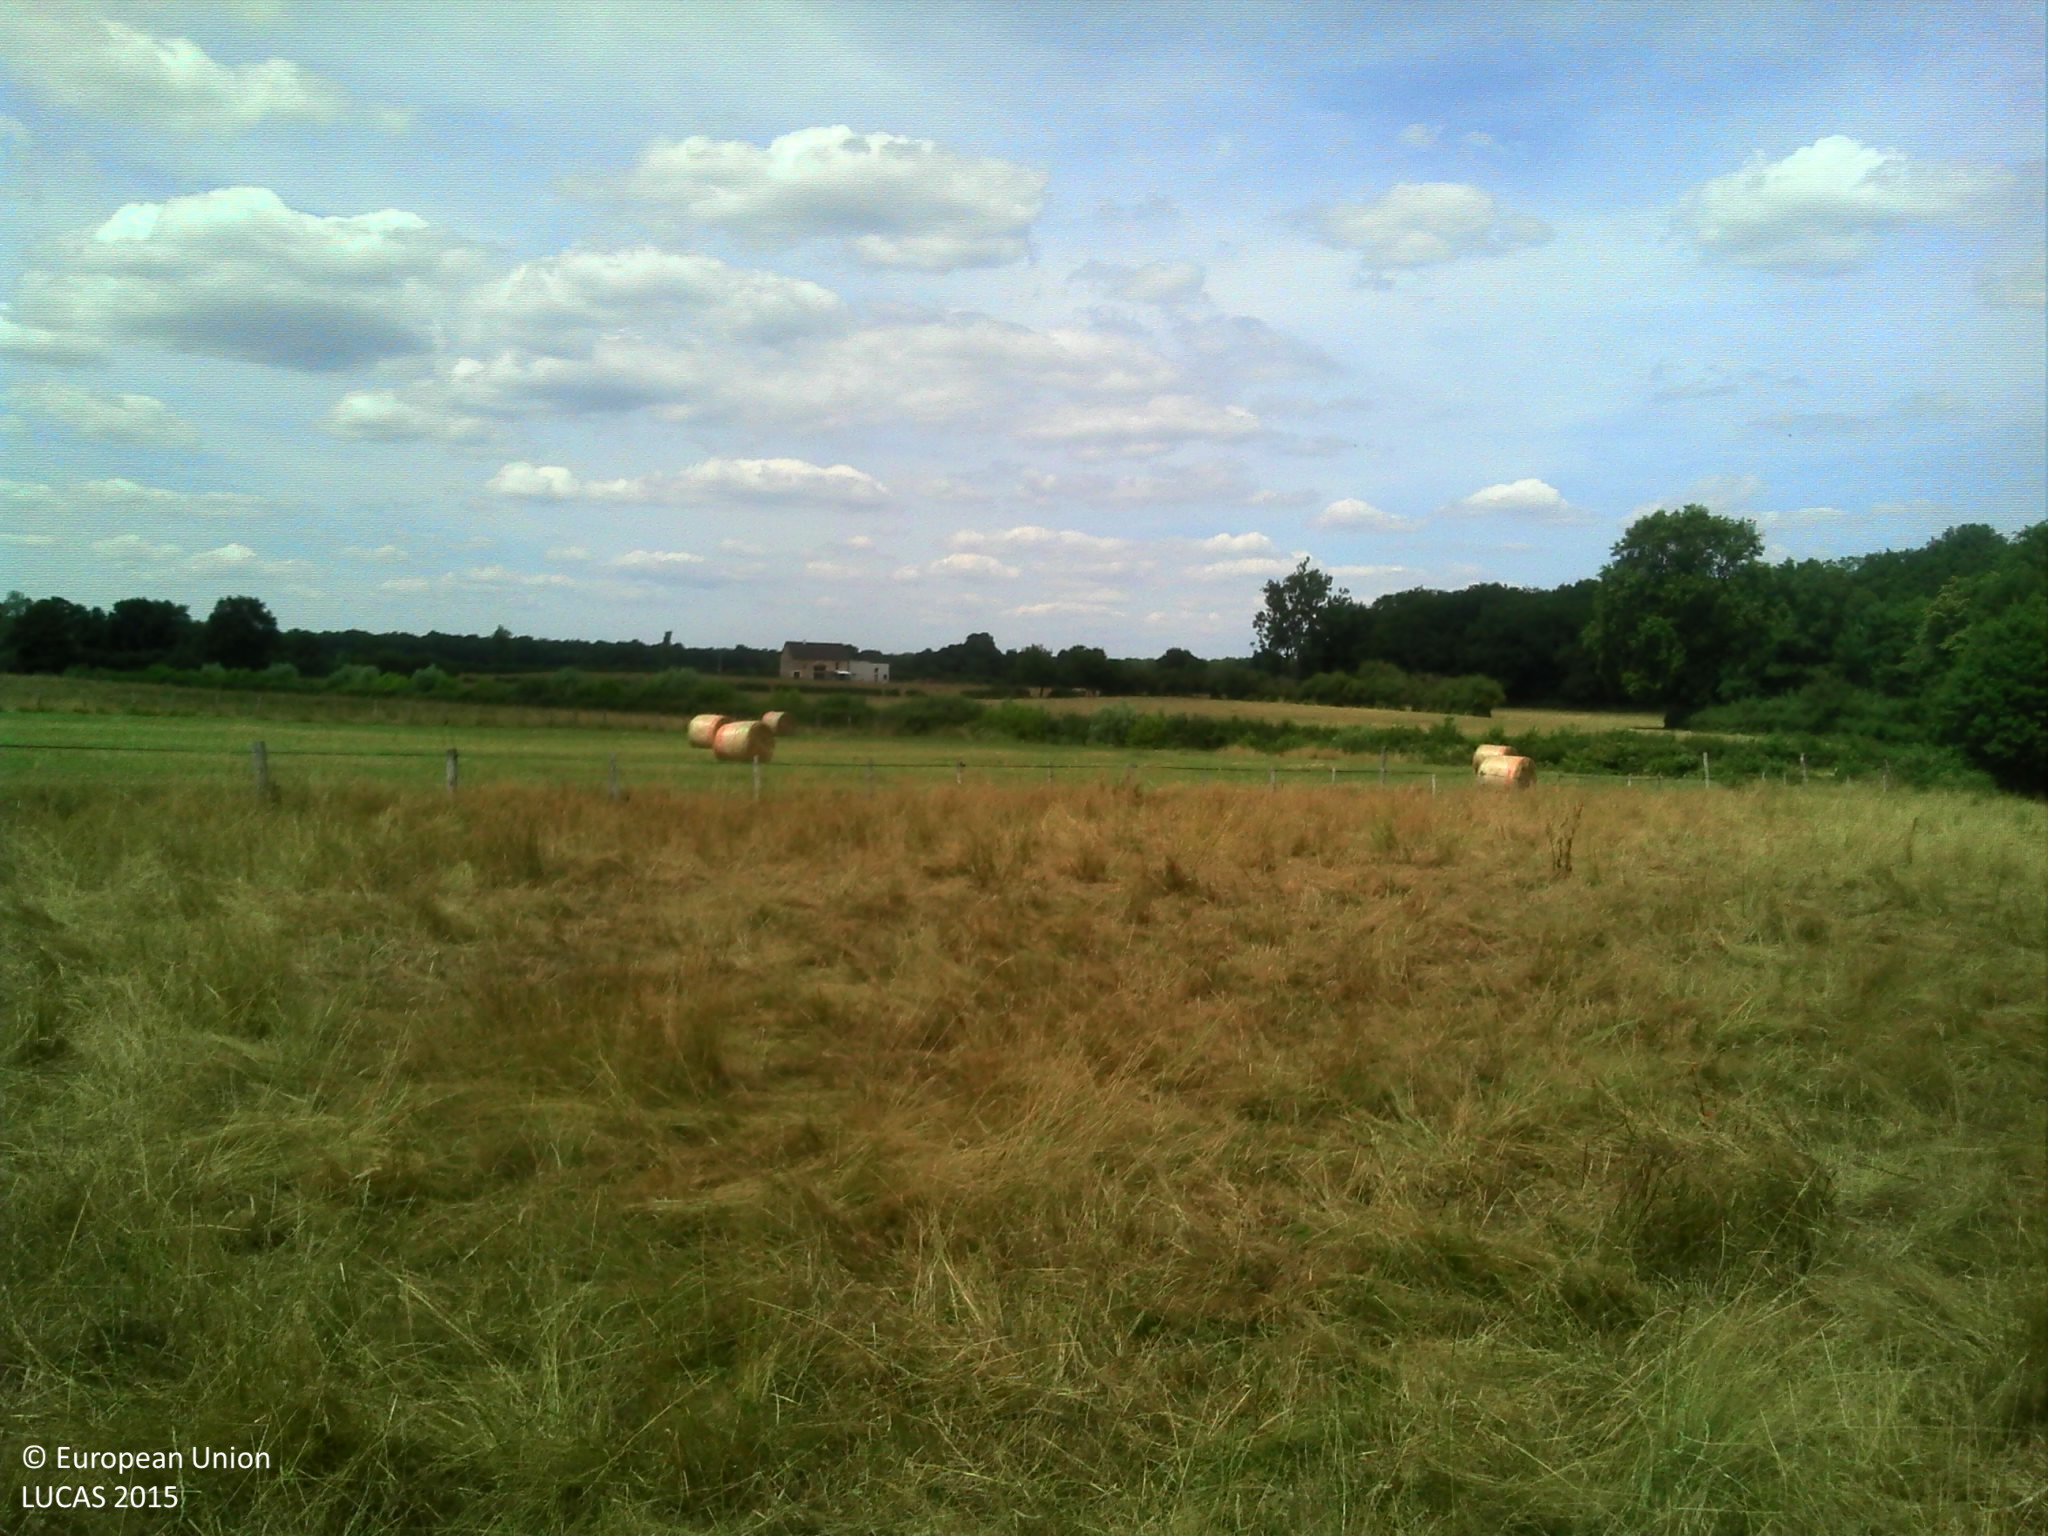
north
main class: Grassland
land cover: Grassland without tree/shrub cover
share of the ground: > 75 %
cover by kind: herbaceous plants 100 %
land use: Agriculture (excluding fallow land and kitchen gardens)
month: June
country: FR
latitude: 46.6560
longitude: 4.7613
